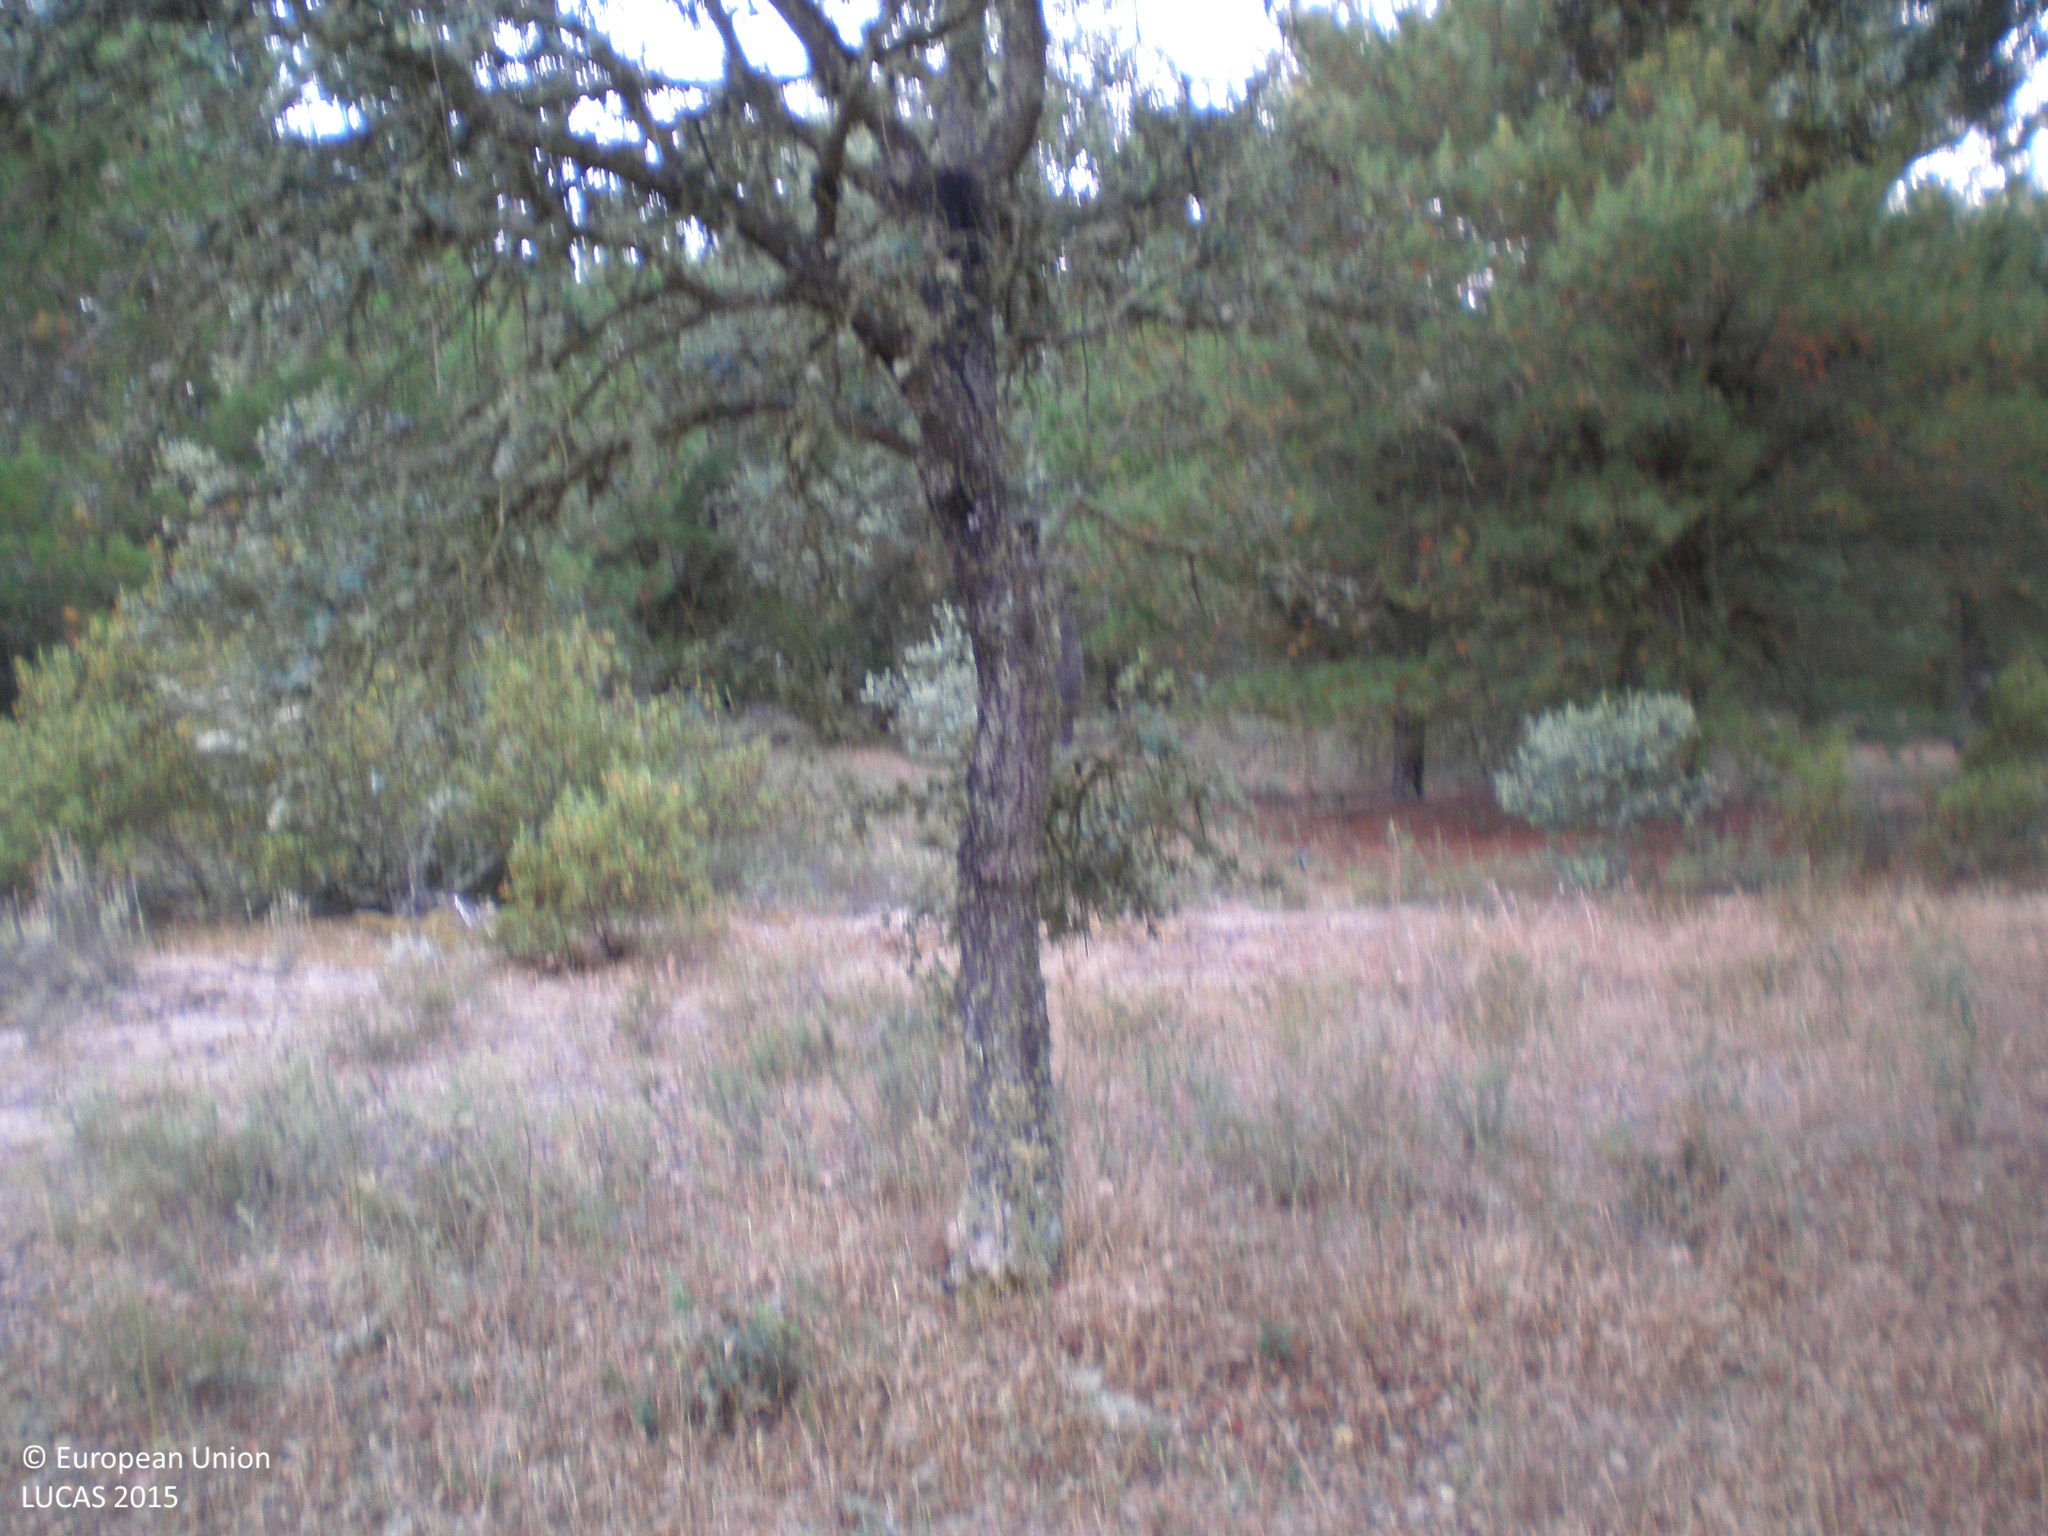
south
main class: Woodland
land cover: Broadleaved woodland
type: broadleaved evergreen forest
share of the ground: 50 - 75 %
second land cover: Grassland without tree/shrub cover
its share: 25 - 50 %
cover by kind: broadleaved forest trees 60 %, herbaceous plants 40 %
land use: Forestry
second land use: Agriculture (excluding fallow land and kitchen gardens)
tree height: > 5 m
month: June
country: ES
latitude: 41.1301
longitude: -5.7941
